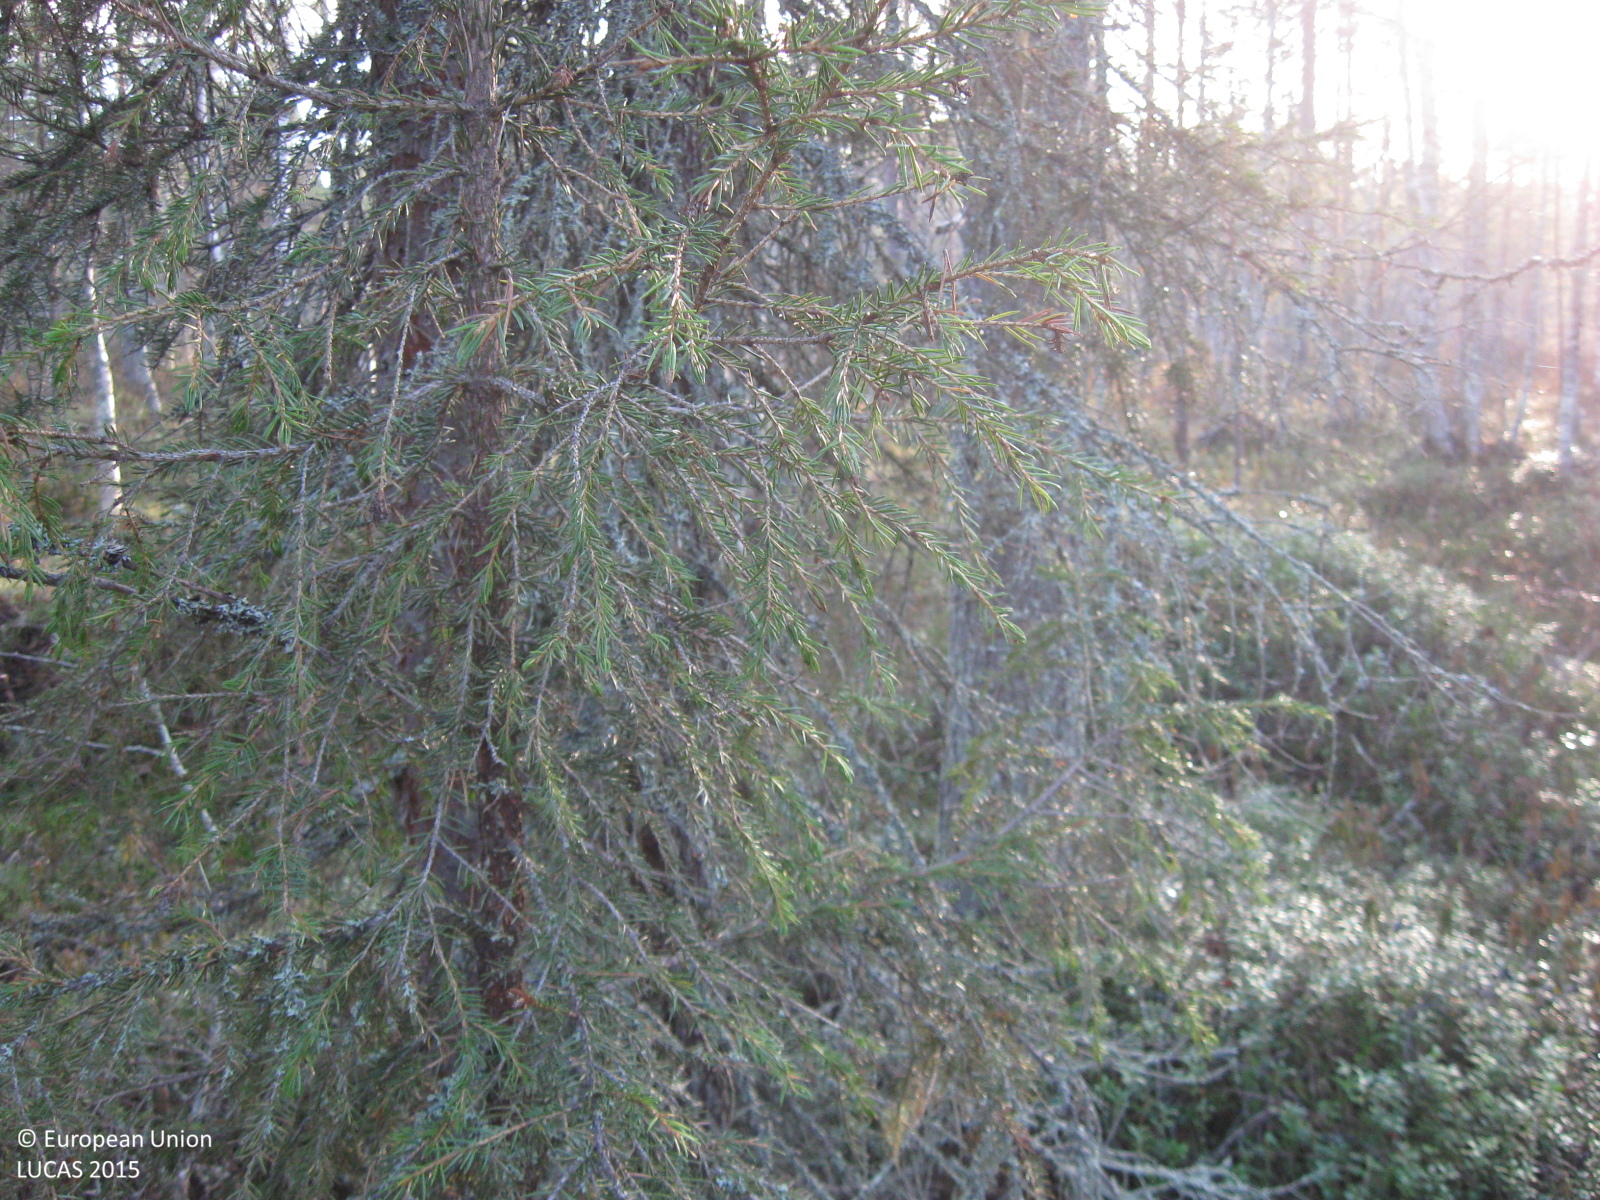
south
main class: Woodland
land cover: Pine dominated mixed woodland
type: boreal forest
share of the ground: > 75 %
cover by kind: coniferous forest trees 60 %, broadleaved forest trees 20 %, shrubs 10 %, herbaceous plants 5 %, lichens and mosses 5 %
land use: Forestry
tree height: > 5 m
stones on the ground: 10 - 25 %
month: October
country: SE
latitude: 66.2198
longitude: 22.1733
